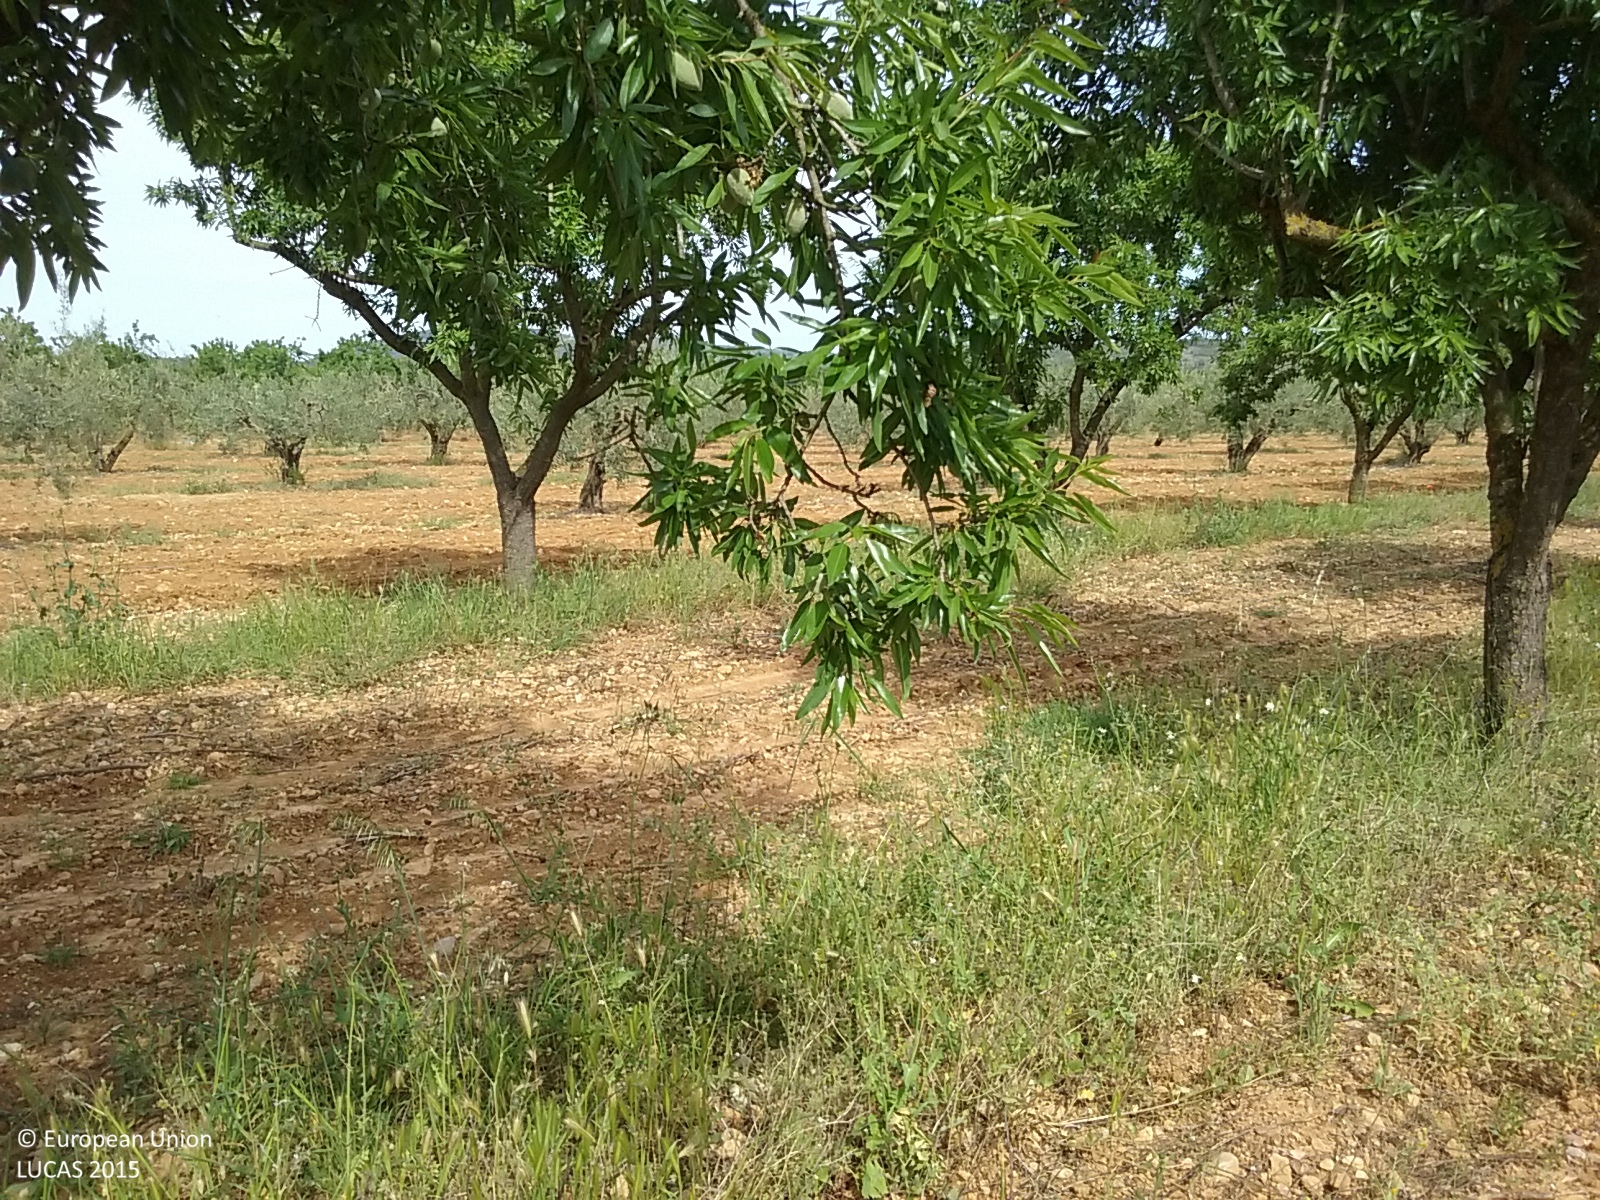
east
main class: Cropland
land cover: Nuts trees
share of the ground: 25 - 50 %
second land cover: Spontaneously vegetated surfaces
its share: 50 - 75 %
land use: Agriculture (excluding fallow land and kitchen gardens)
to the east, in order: Nuts trees; Spontaneously vegetated surfaces; Olive groves; Nuts trees; Tracks; Grass margins; Nuts trees; Grass margins; Barley; Grass margins; Nuts trees
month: May
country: ES
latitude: 40.1769
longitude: 0.0271
